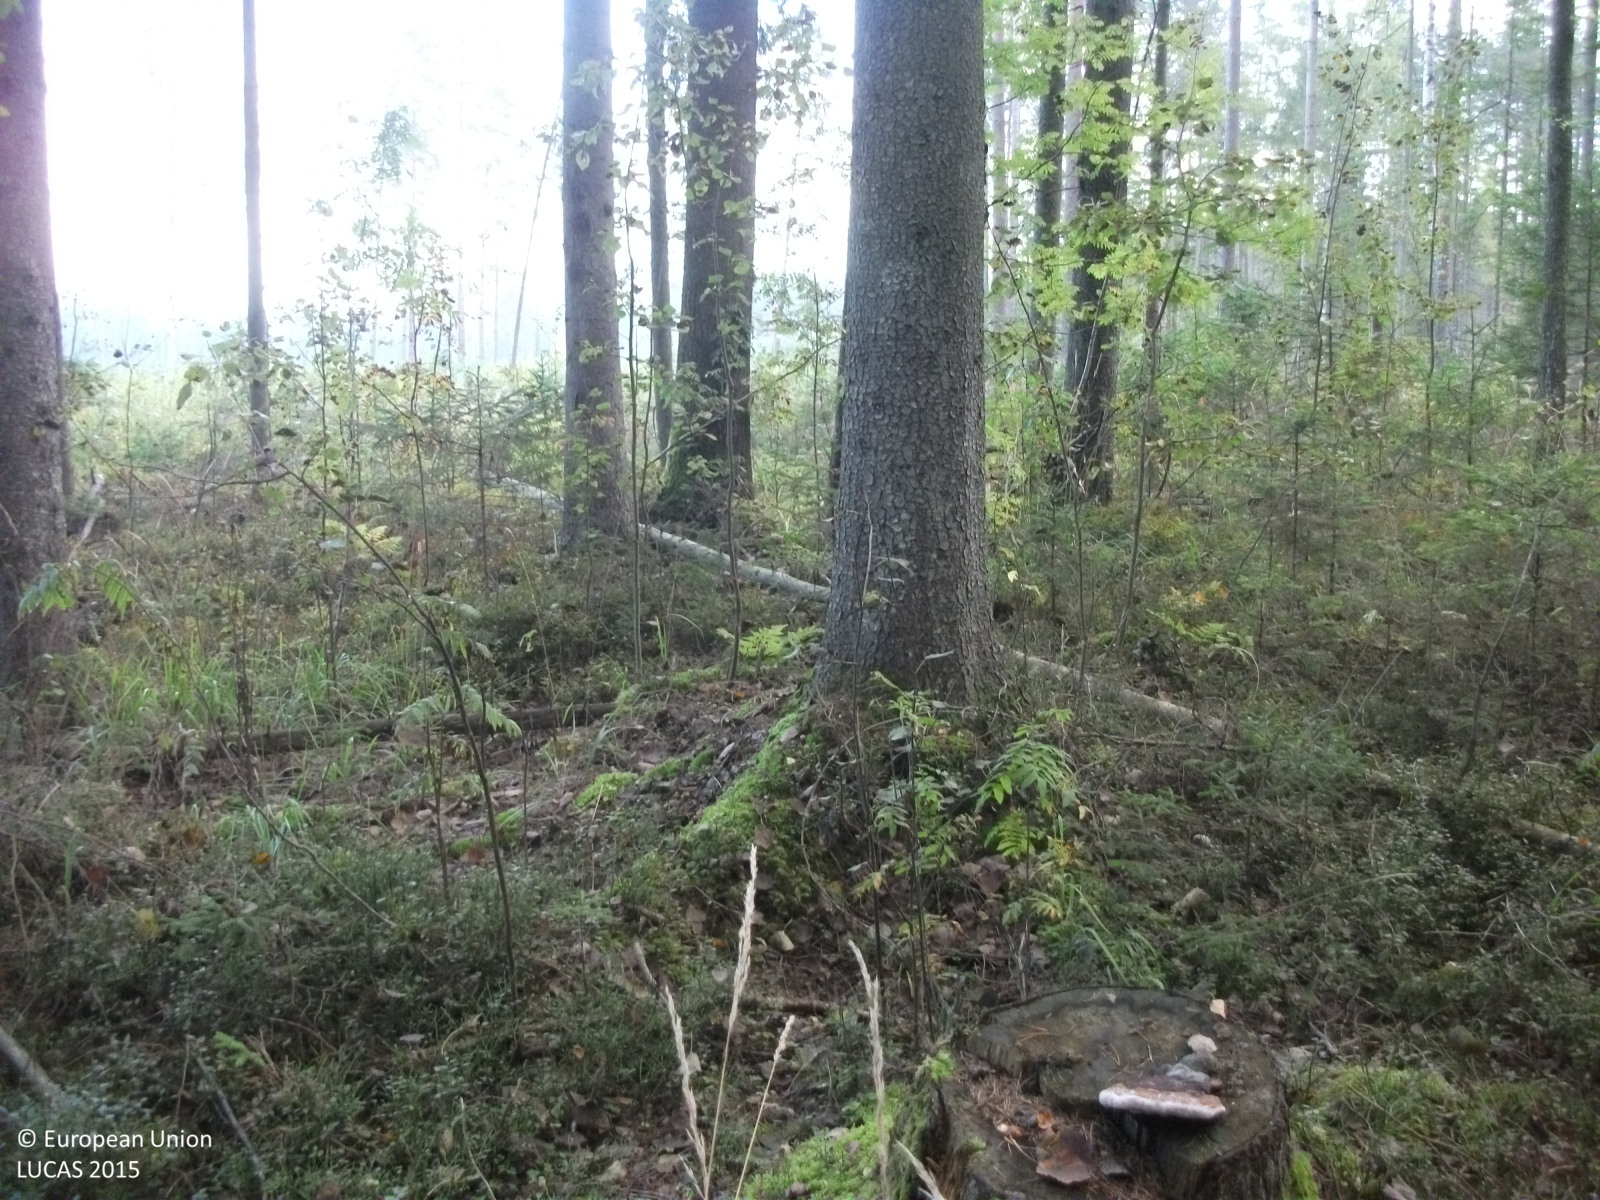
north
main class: Woodland
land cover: Spruce dominated coniferous woodland
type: hemiboreal forest and nemoral coniferous forest and mixed broadleaved-coniferous forest
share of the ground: > 75 %
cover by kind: coniferous forest trees 80 %, broadleaved forest trees 10 %, shrubs 5 %, herbaceous plants 5 %
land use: Forestry
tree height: > 5 m
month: September
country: LV
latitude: 57.9018
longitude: 24.5156
